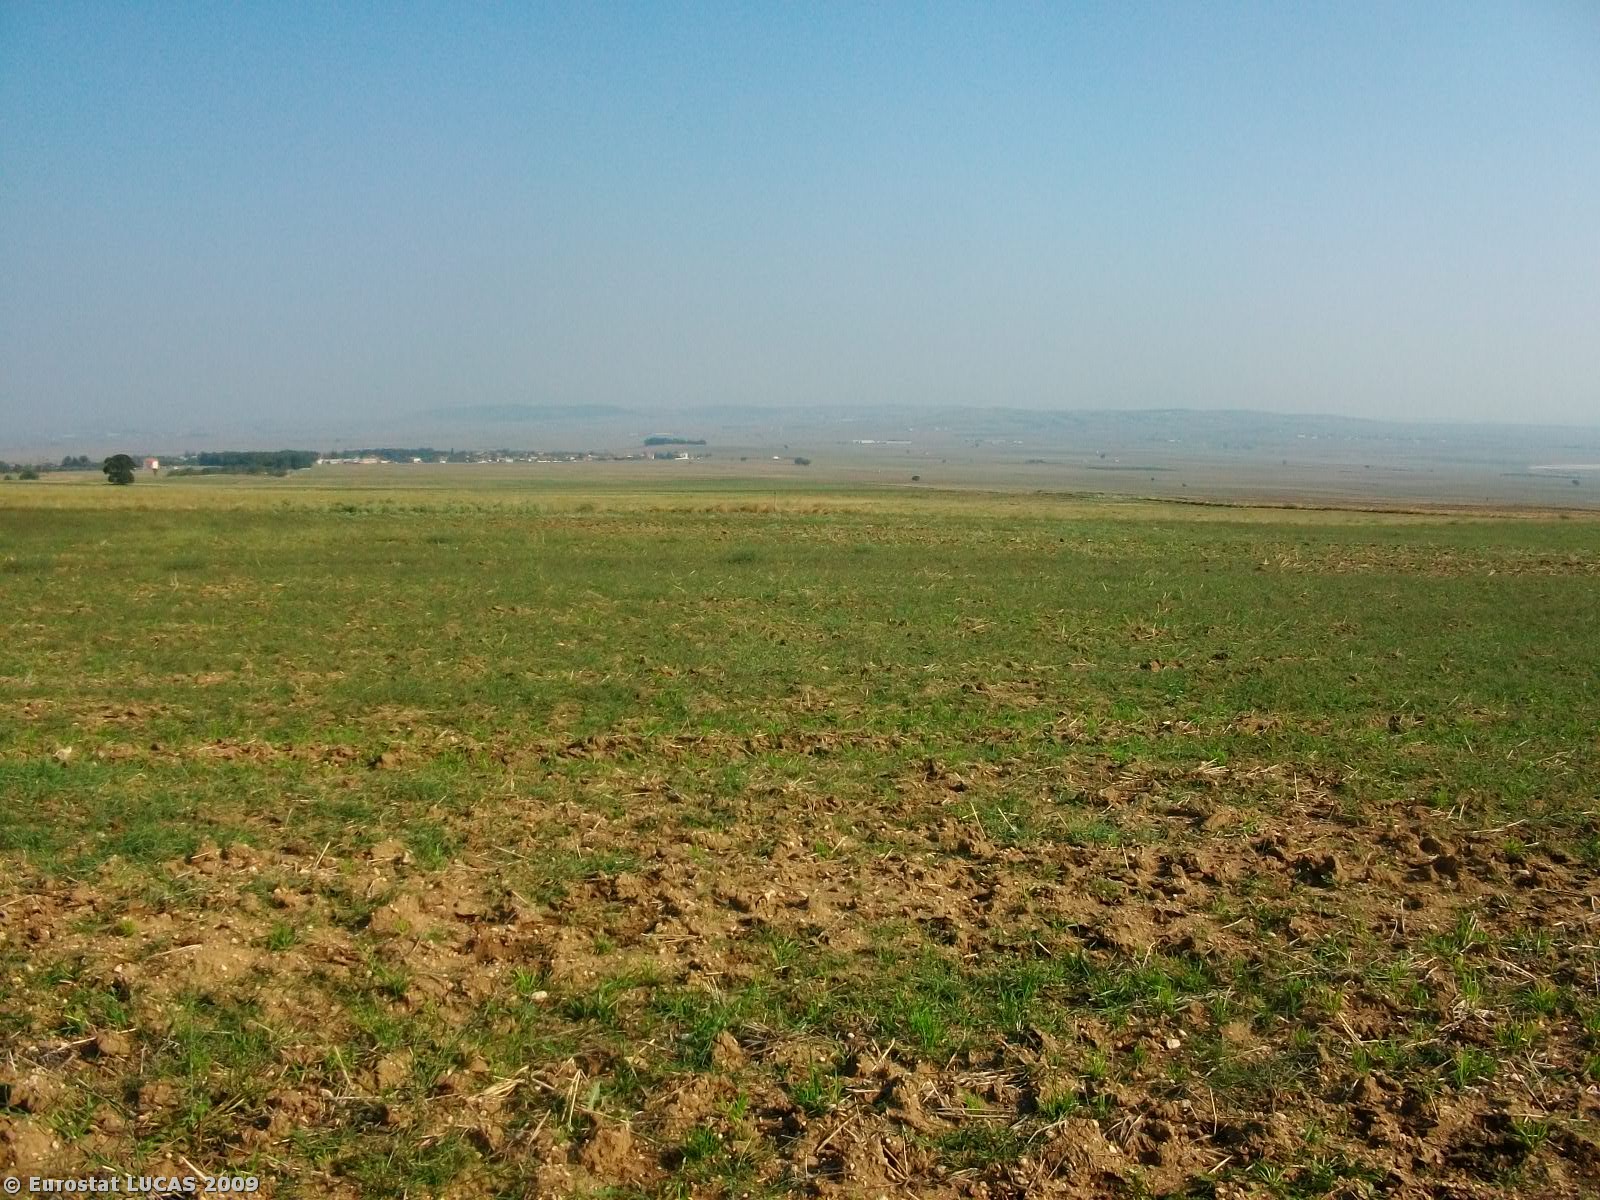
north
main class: Cropland
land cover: Durum wheat
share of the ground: < 10 %
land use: Agriculture (excluding fallow land and kitchen gardens)
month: September
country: GR
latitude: 40.8181
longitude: 22.7762
